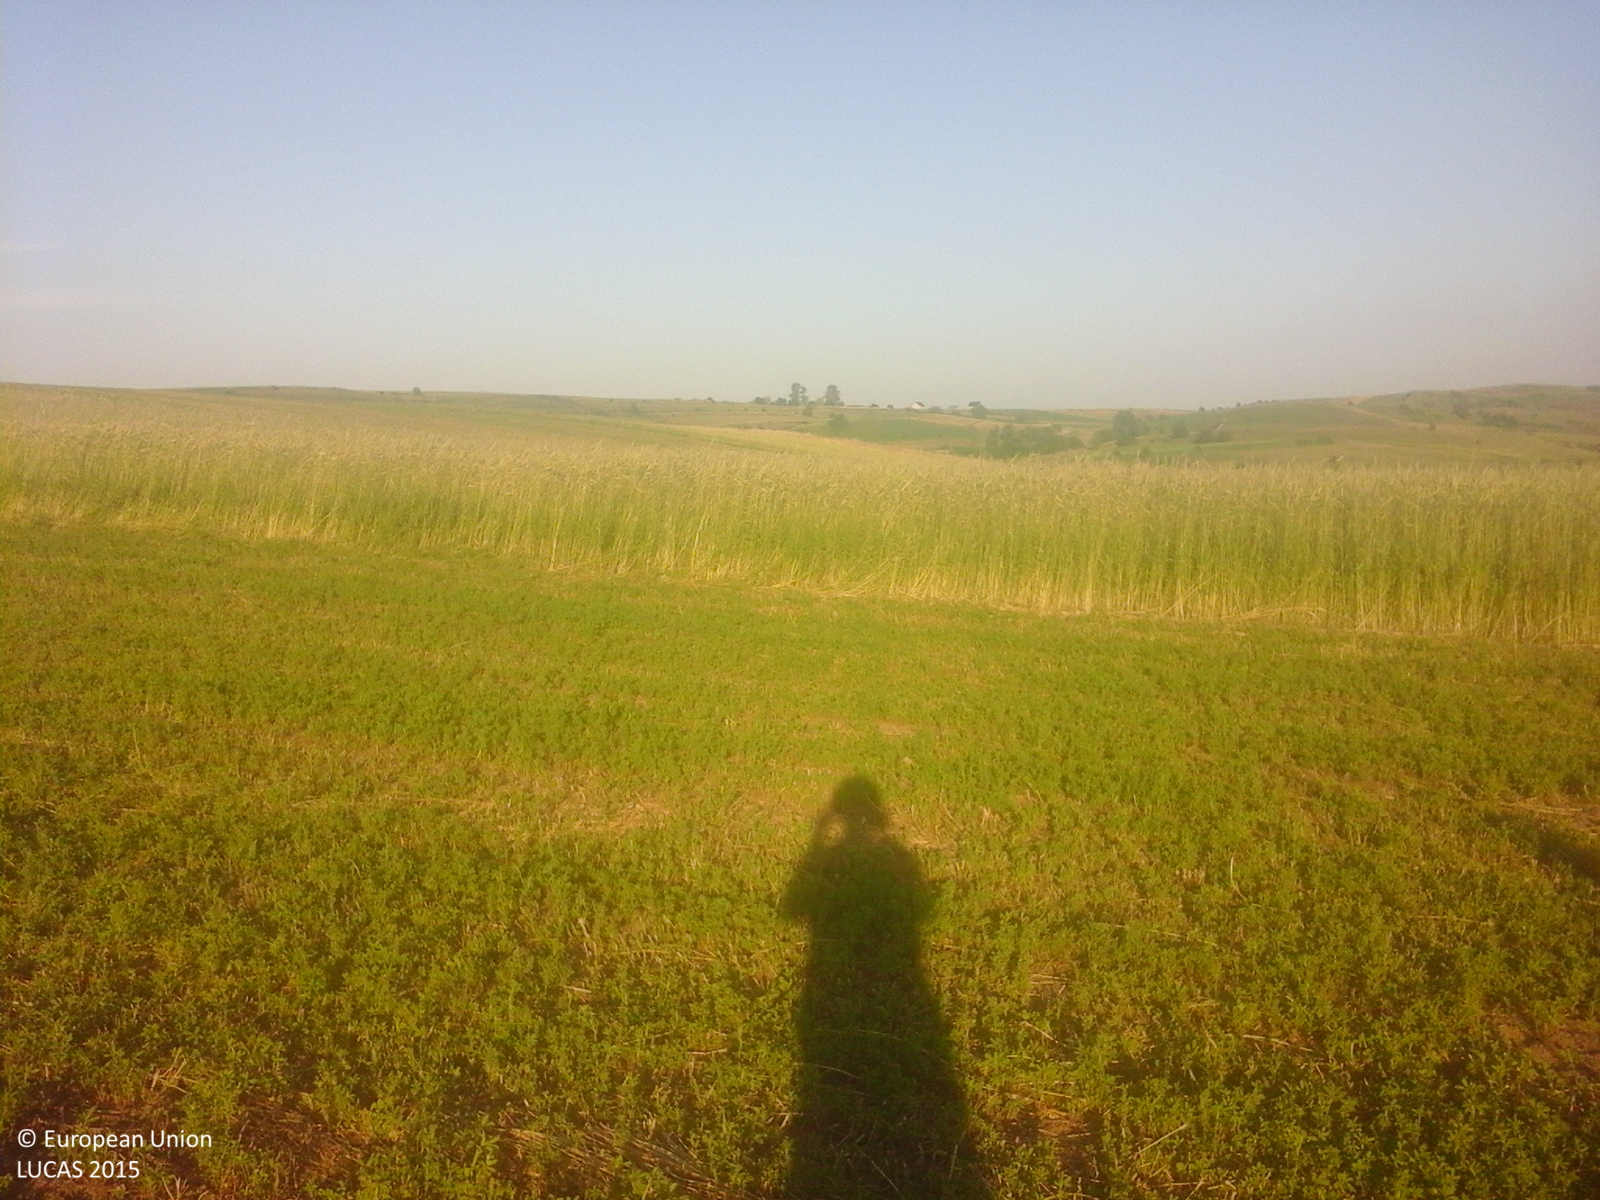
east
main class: Cropland
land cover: Lucerne
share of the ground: 25 - 50 %
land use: Agriculture (excluding fallow land and kitchen gardens)
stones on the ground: < 10 %
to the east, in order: Lucerne; Rye; Lucerne; Grassland without tree/shrub cover; Common wheat; Tracks; Dry pulses
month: June
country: RO
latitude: 47.9578
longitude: 26.0285
